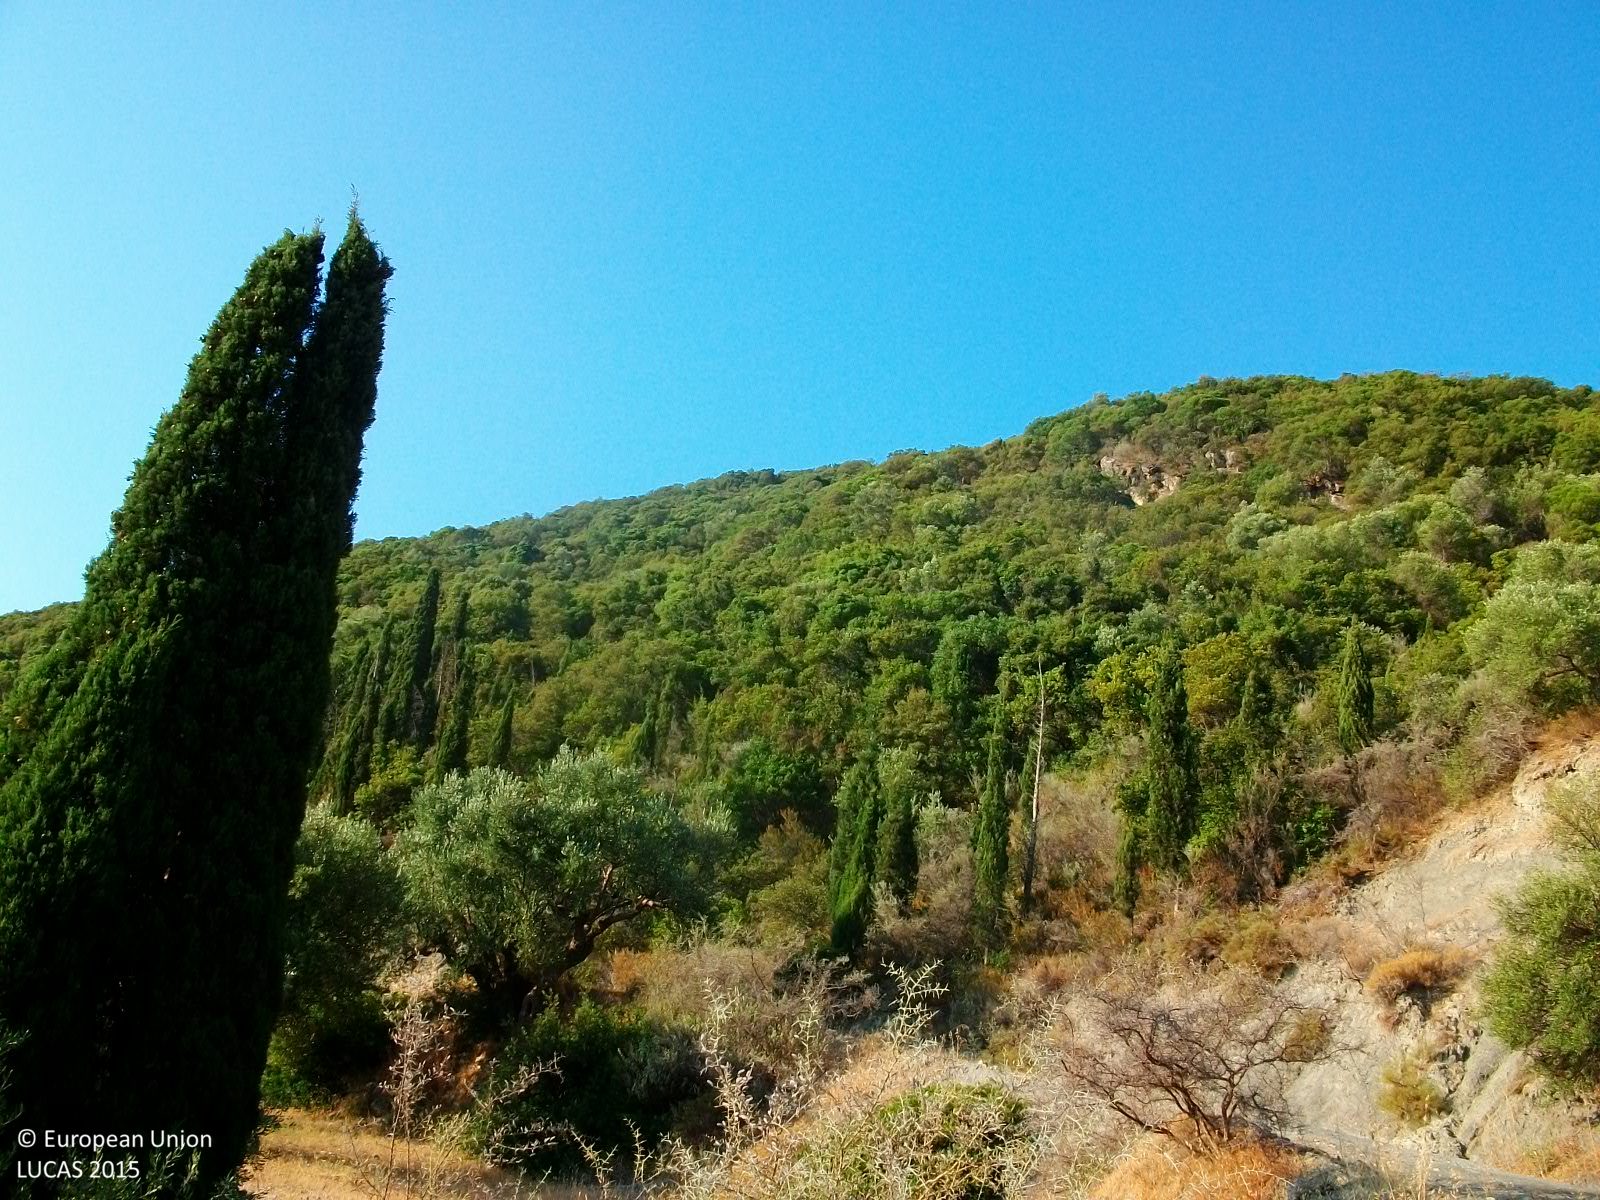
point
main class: Shrubland
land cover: Shrubland with sparse tree cover
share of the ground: > 75 %
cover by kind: shrubs 95 %, coniferous forest trees 5 %
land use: Semi-natural and natural areas not in use
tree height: > 5 m
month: July
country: GR
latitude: 36.7592
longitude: 21.9008
